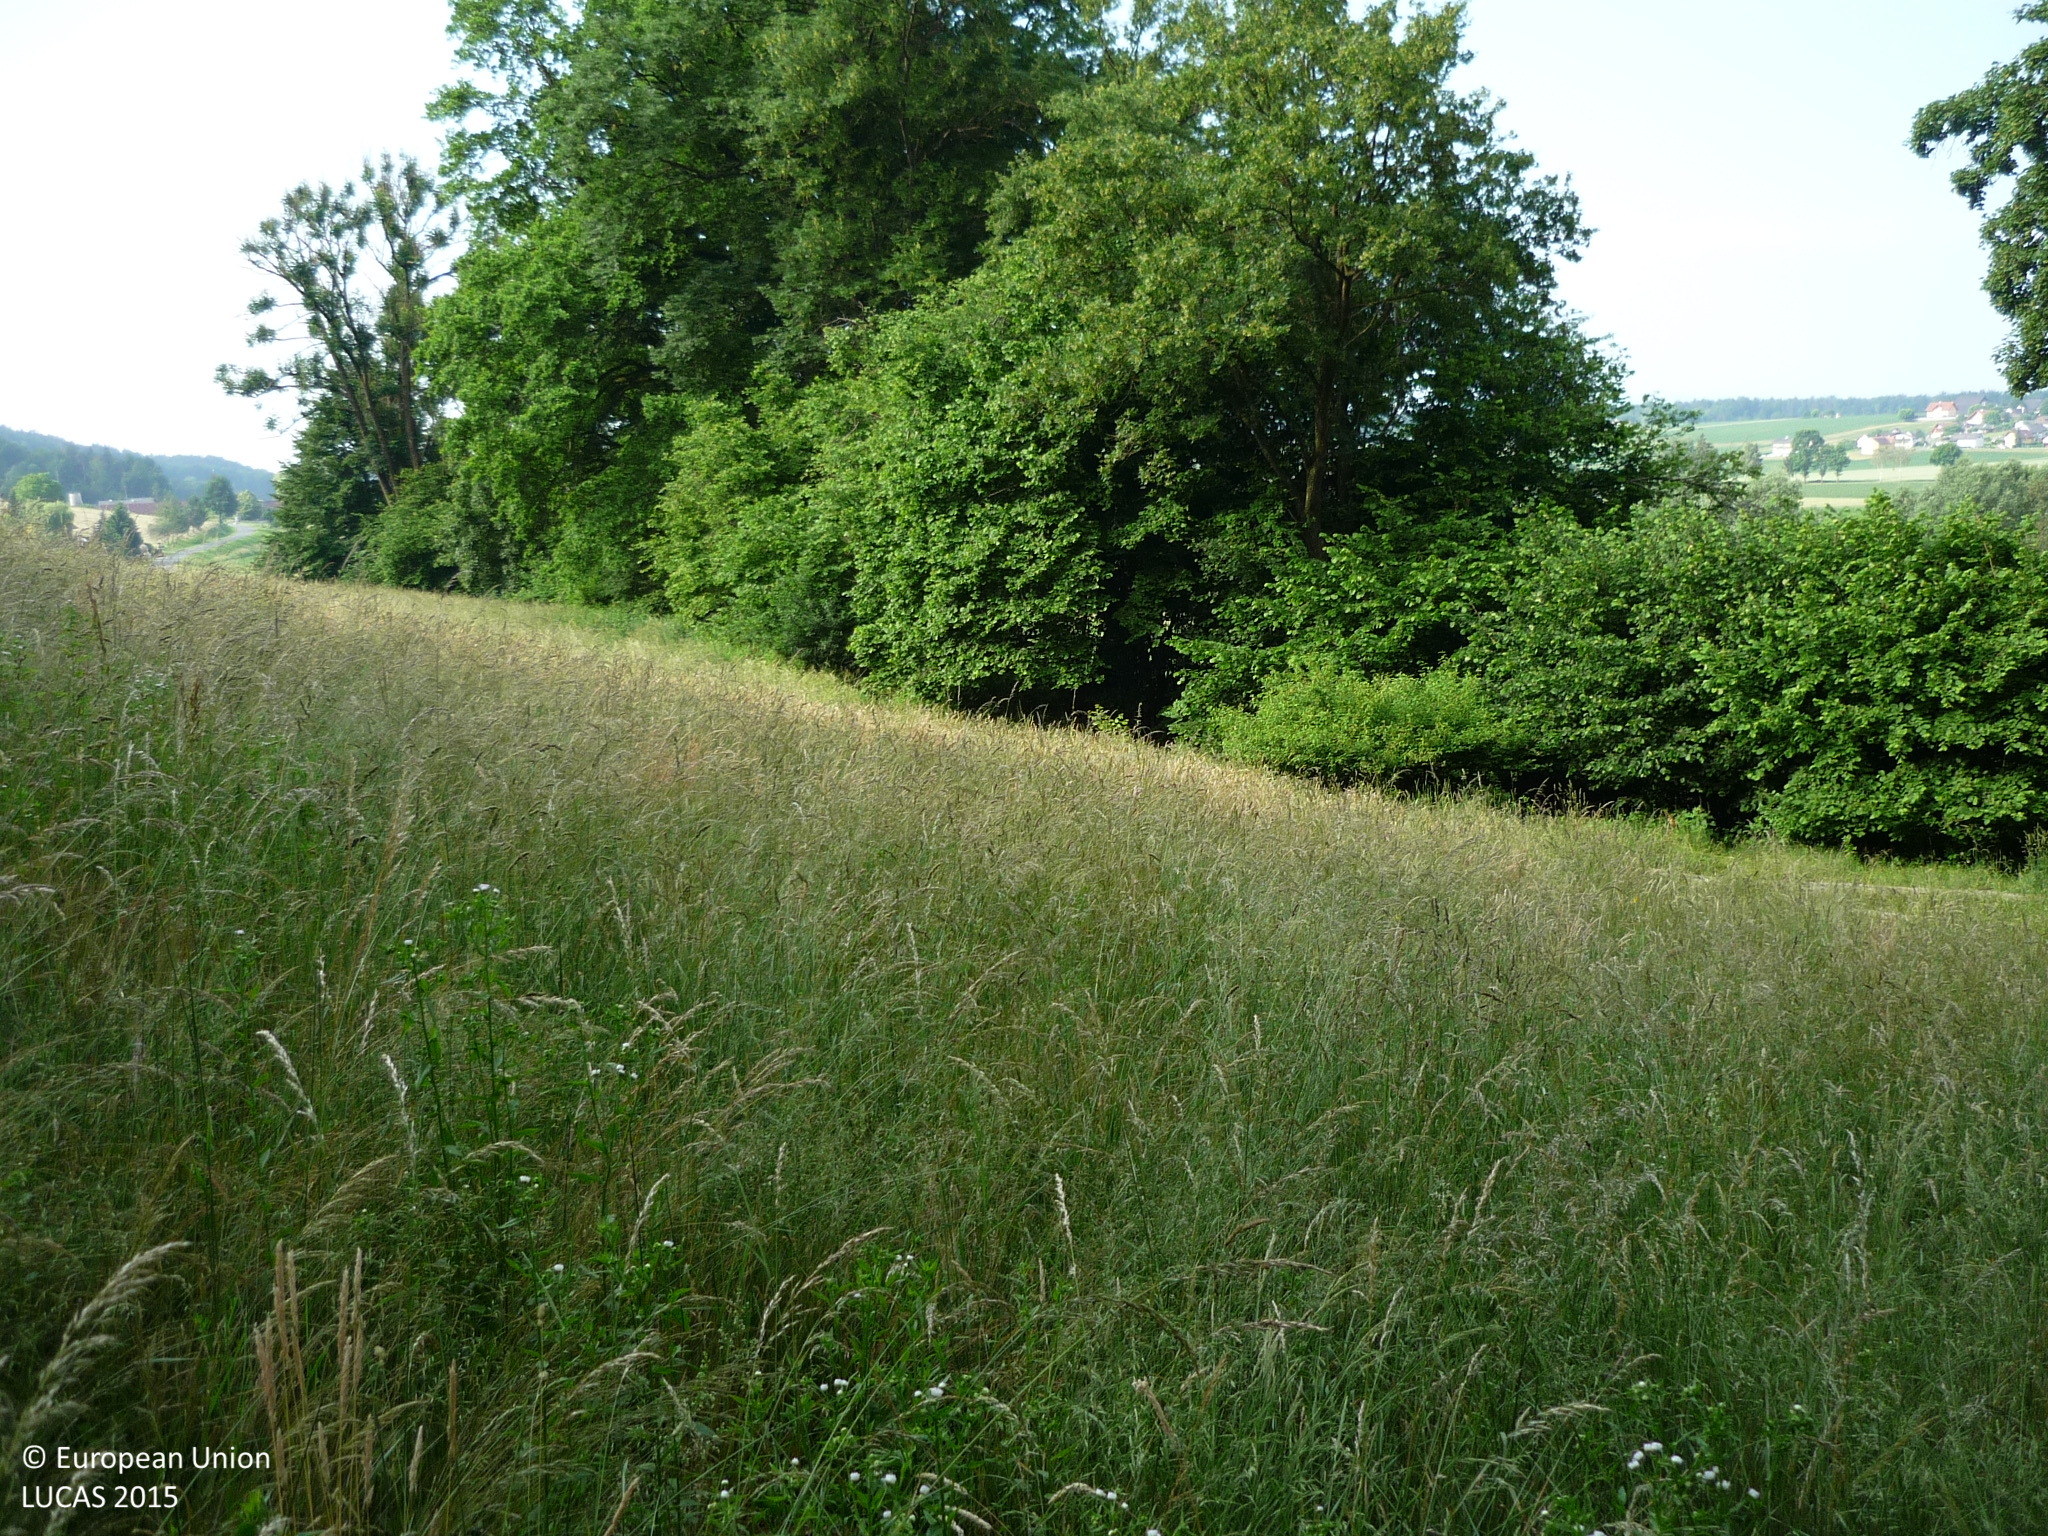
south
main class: Grassland
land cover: Grassland without tree/shrub cover
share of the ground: > 75 %
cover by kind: herbaceous plants 100 %
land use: Agriculture (excluding fallow land and kitchen gardens)
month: June
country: AT
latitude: 46.8157
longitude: 15.6485
